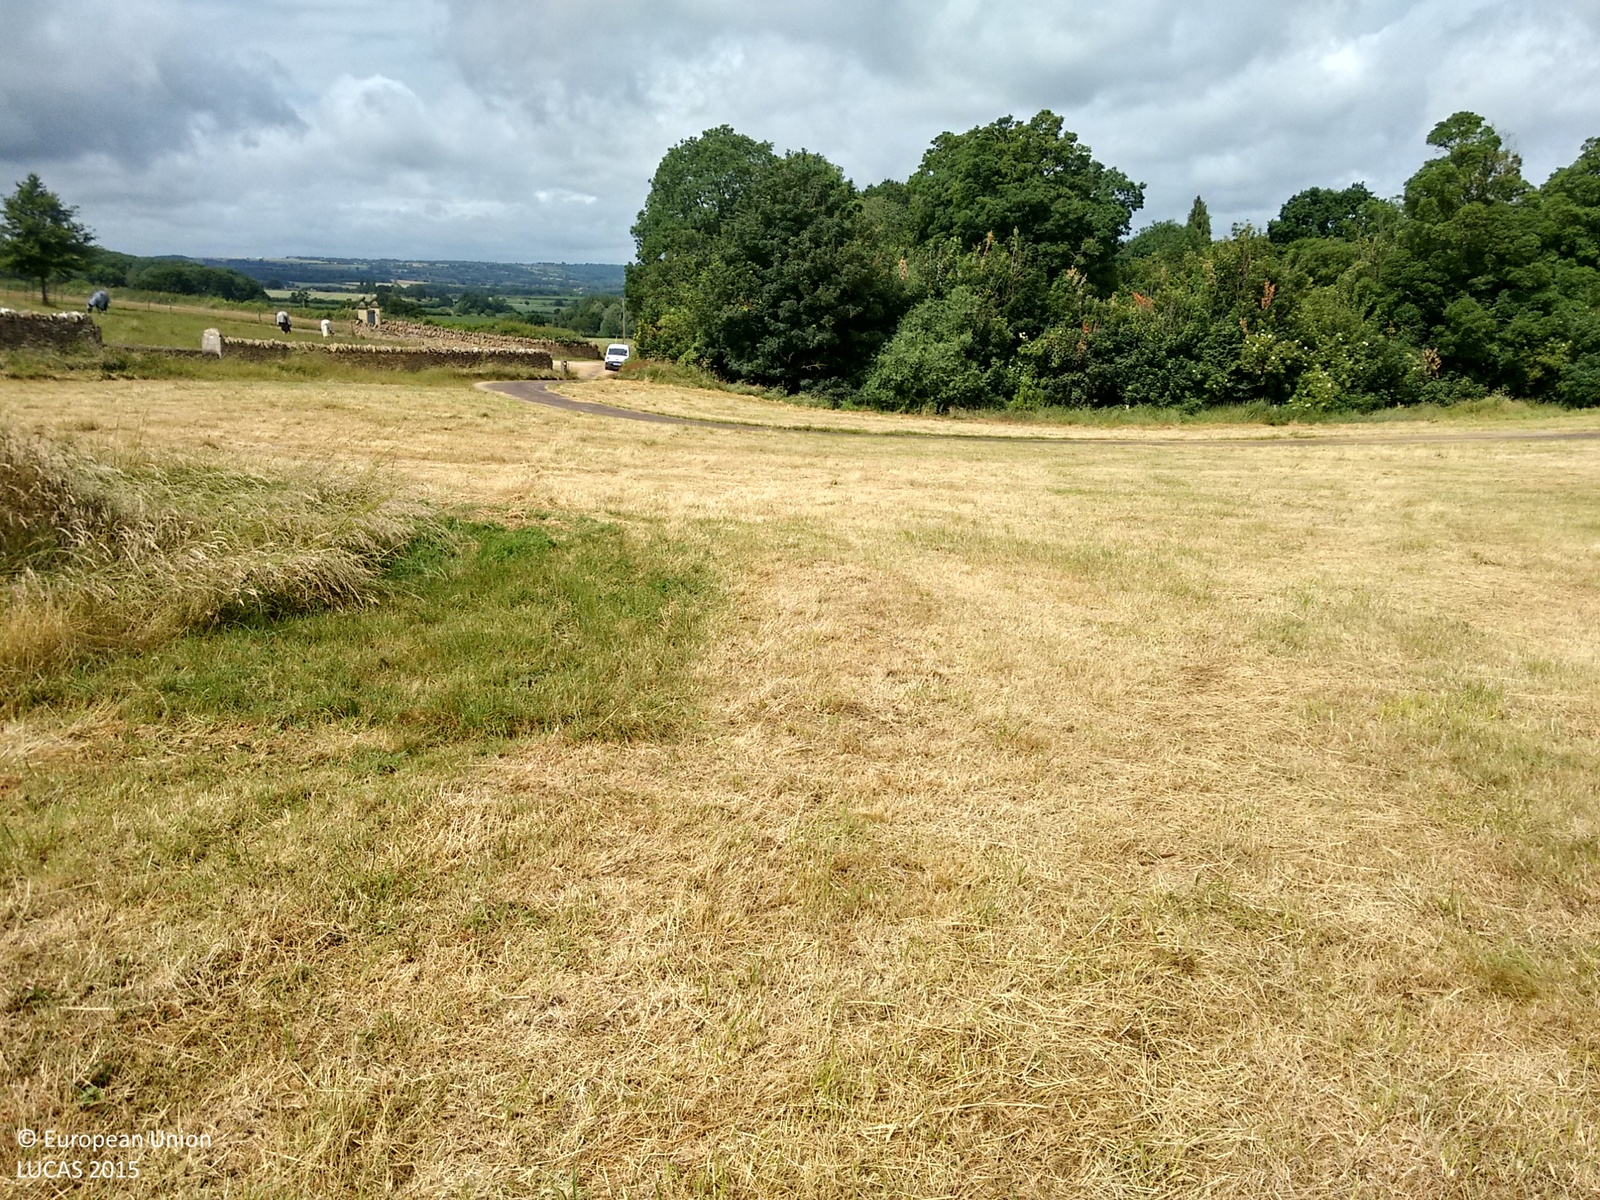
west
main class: Grassland
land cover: Grassland without tree/shrub cover
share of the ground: > 75 %
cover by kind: herbaceous plants 100 %
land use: Residential
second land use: Agriculture (excluding fallow land and kitchen gardens)
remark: Harvested field
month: July
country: GB
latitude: 51.8997
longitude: -1.5771
